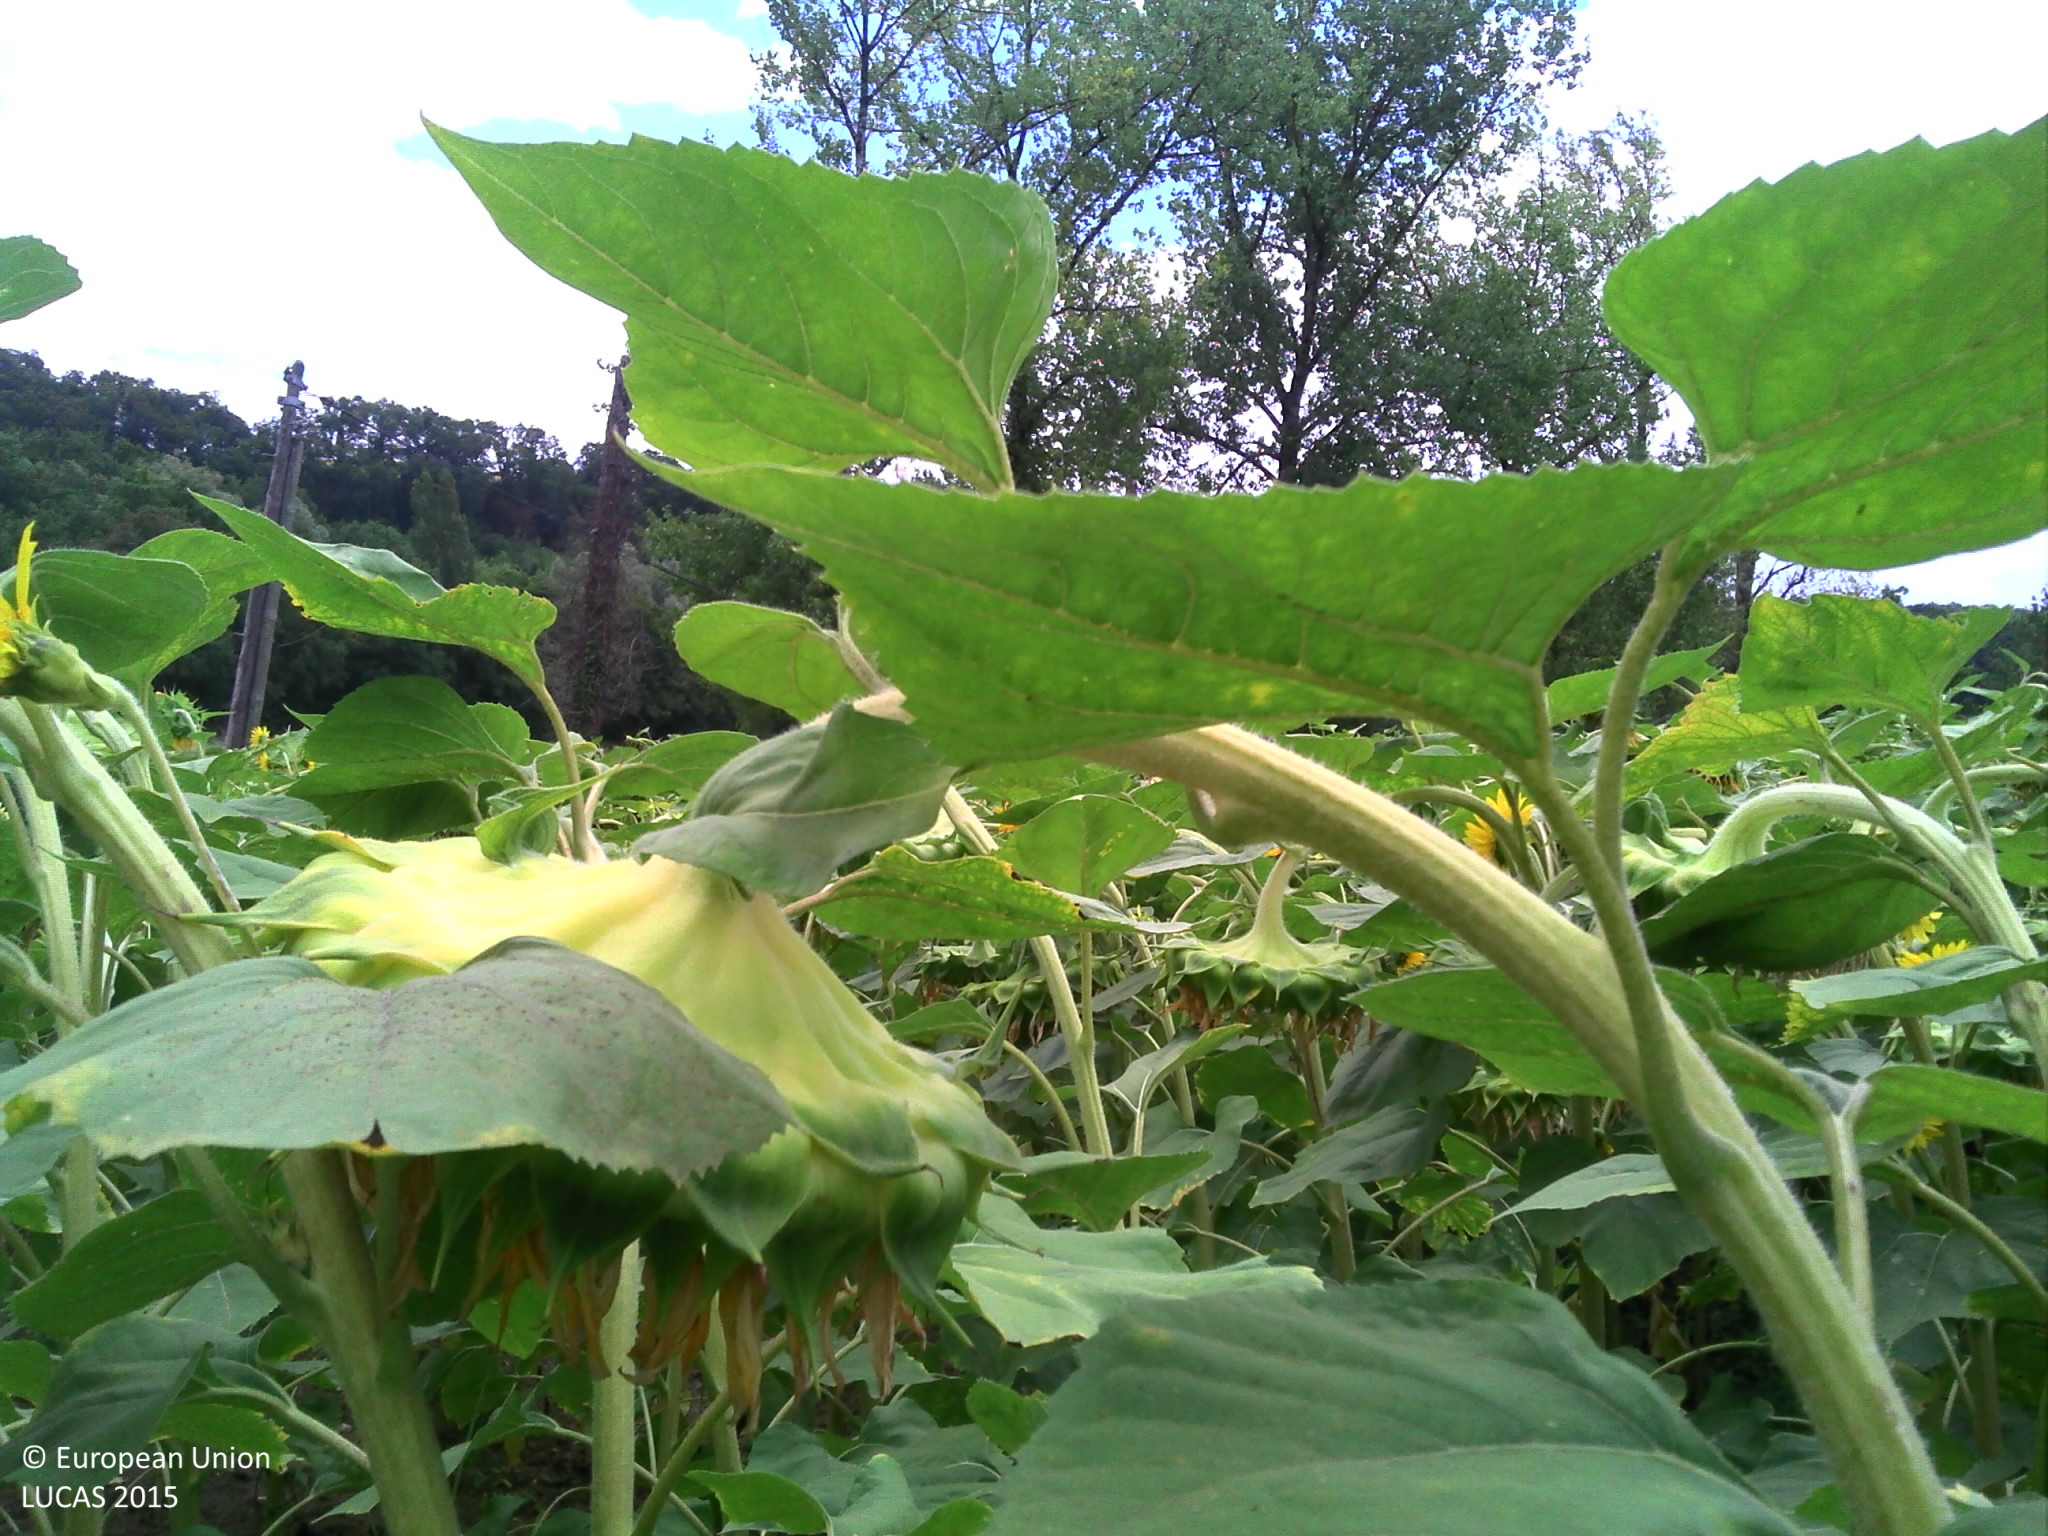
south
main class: Cropland
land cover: Sunflower
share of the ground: > 75 %
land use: Agriculture (excluding fallow land and kitchen gardens)
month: July
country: FR
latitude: 44.3023
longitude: 0.5803
